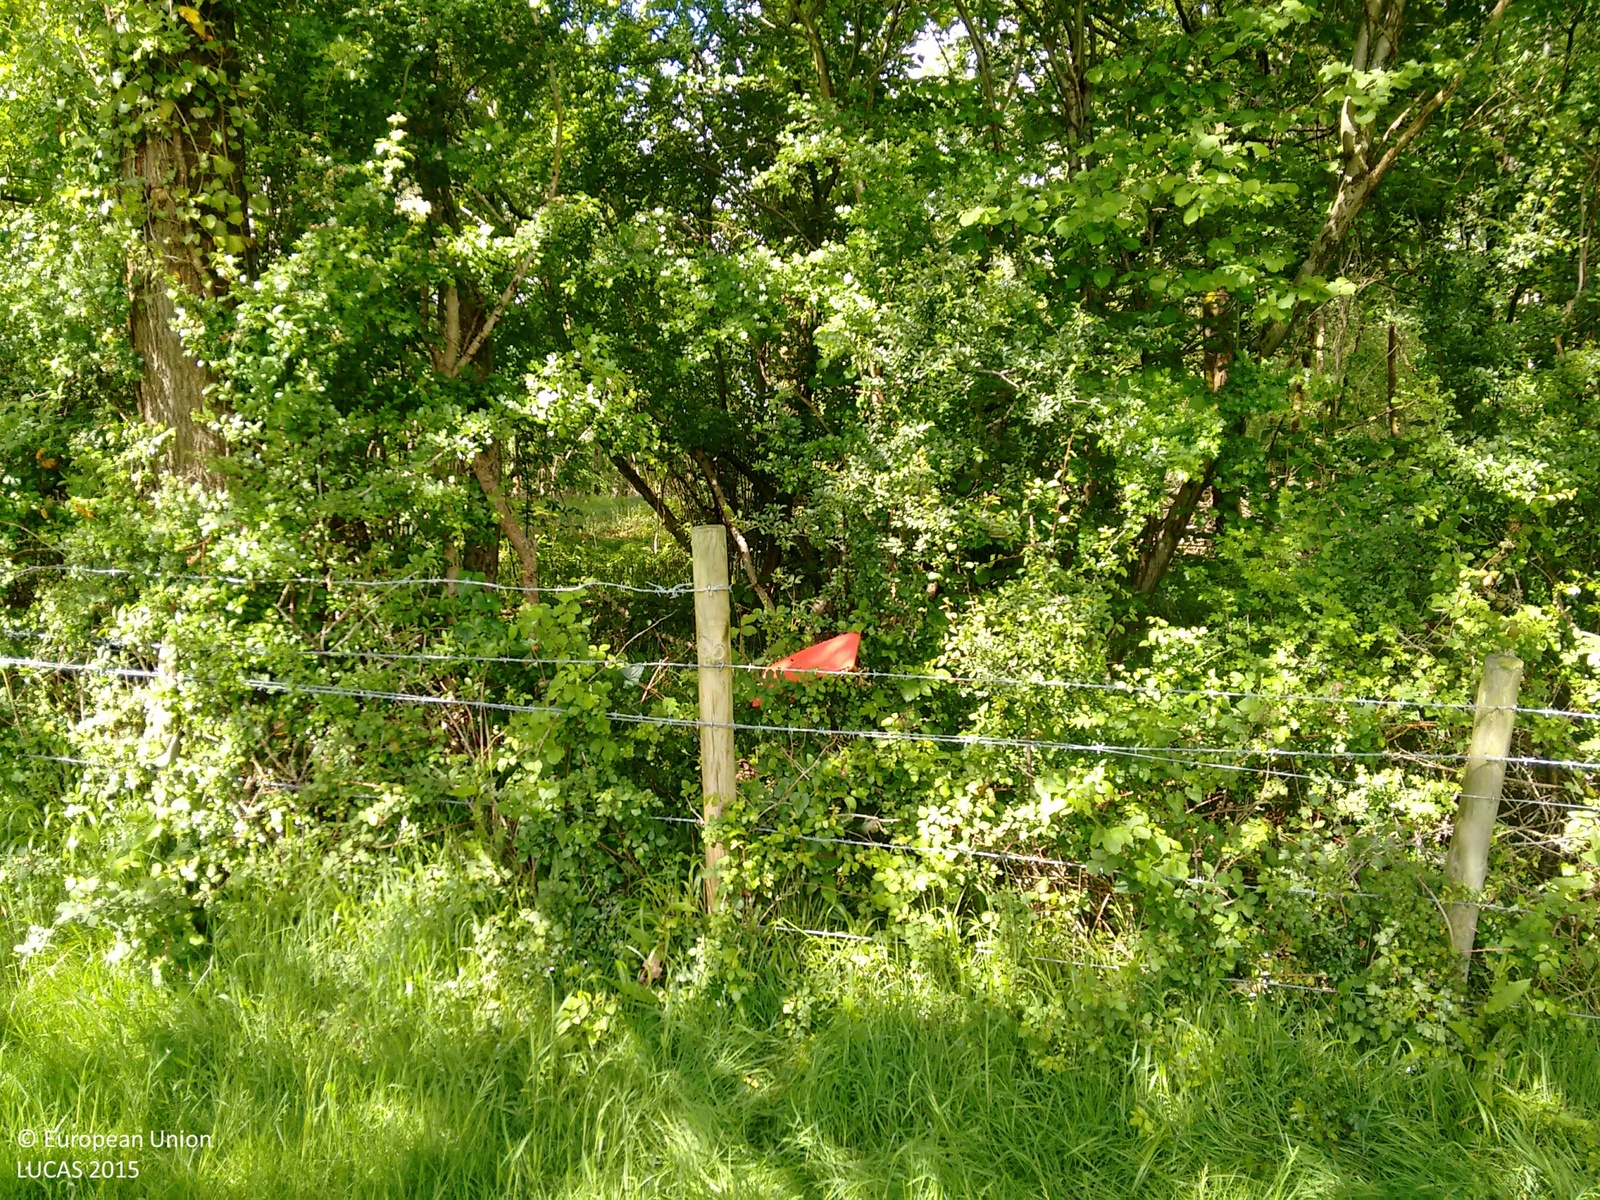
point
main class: Woodland
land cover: Broadleaved woodland
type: mesophytic deciduous forest
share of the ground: > 75 %
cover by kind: broadleaved forest trees 100 %
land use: Forestry
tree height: > 5 m
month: May
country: GB
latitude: 51.0108
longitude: -1.3806
